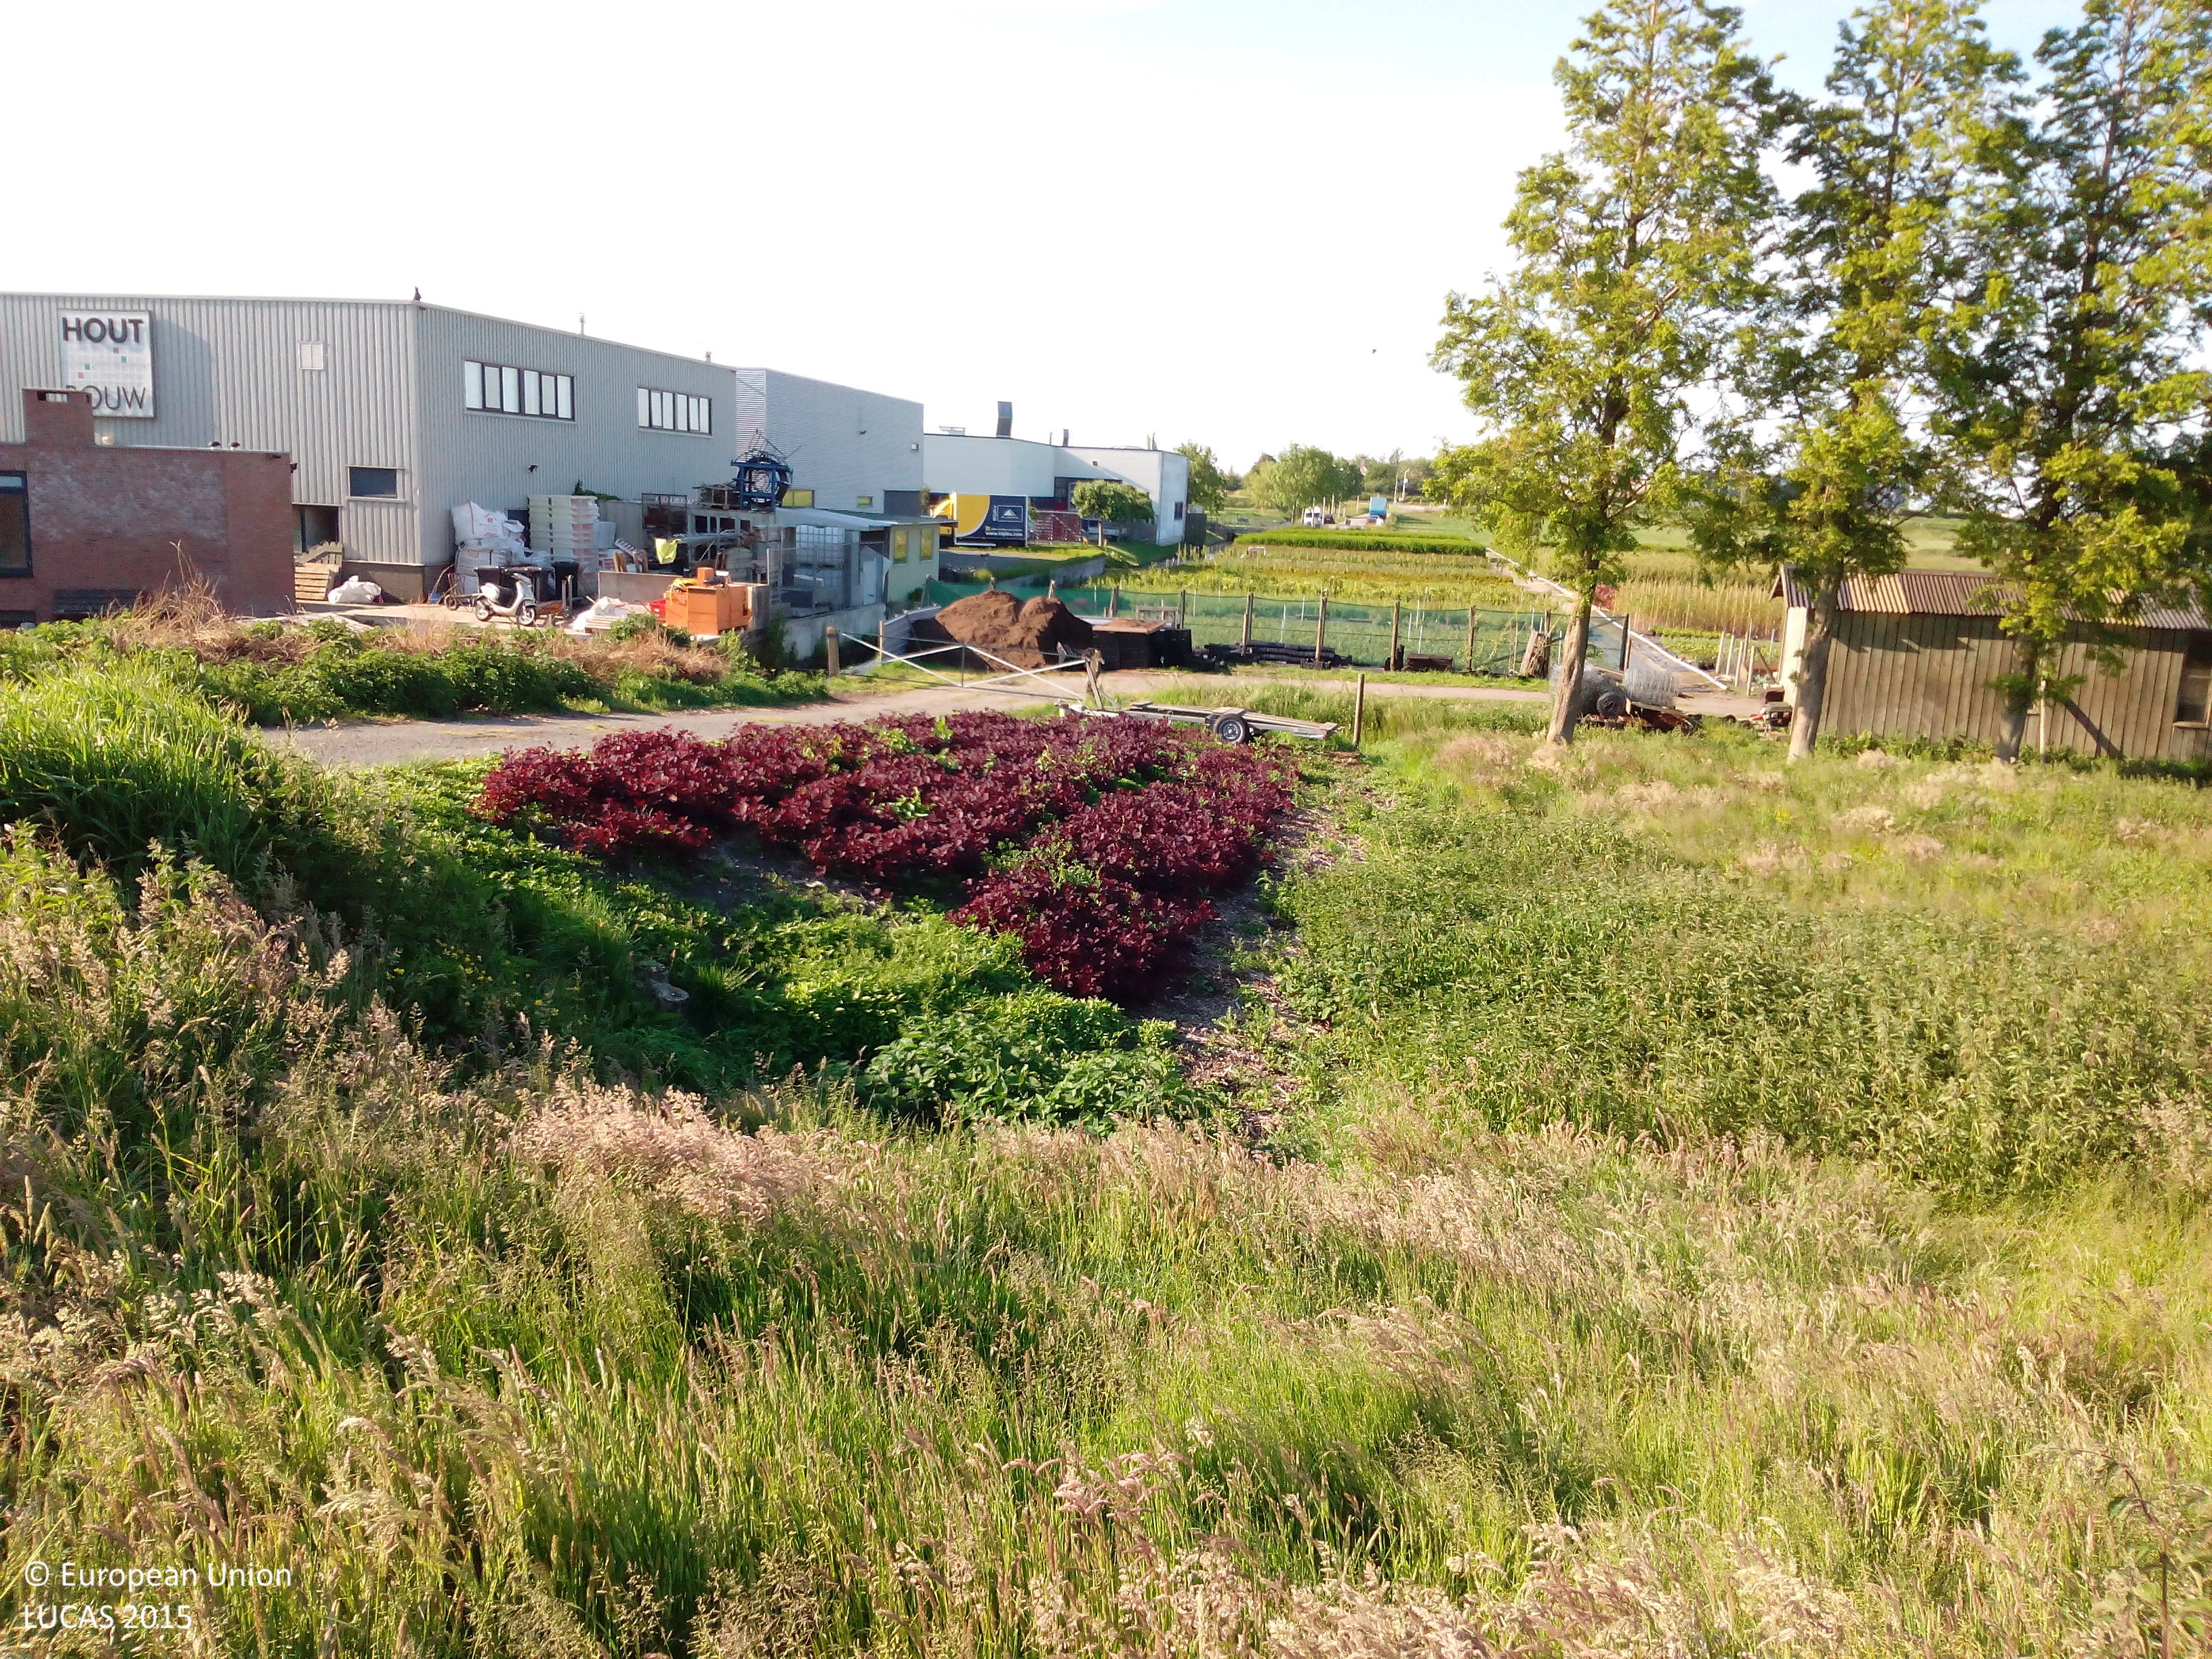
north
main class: Grassland
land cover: Grassland without tree/shrub cover
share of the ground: > 75 %
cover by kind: herbaceous plants 100 %
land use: Abandoned areas
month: June
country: NL
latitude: 52.2223
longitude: 4.6827
